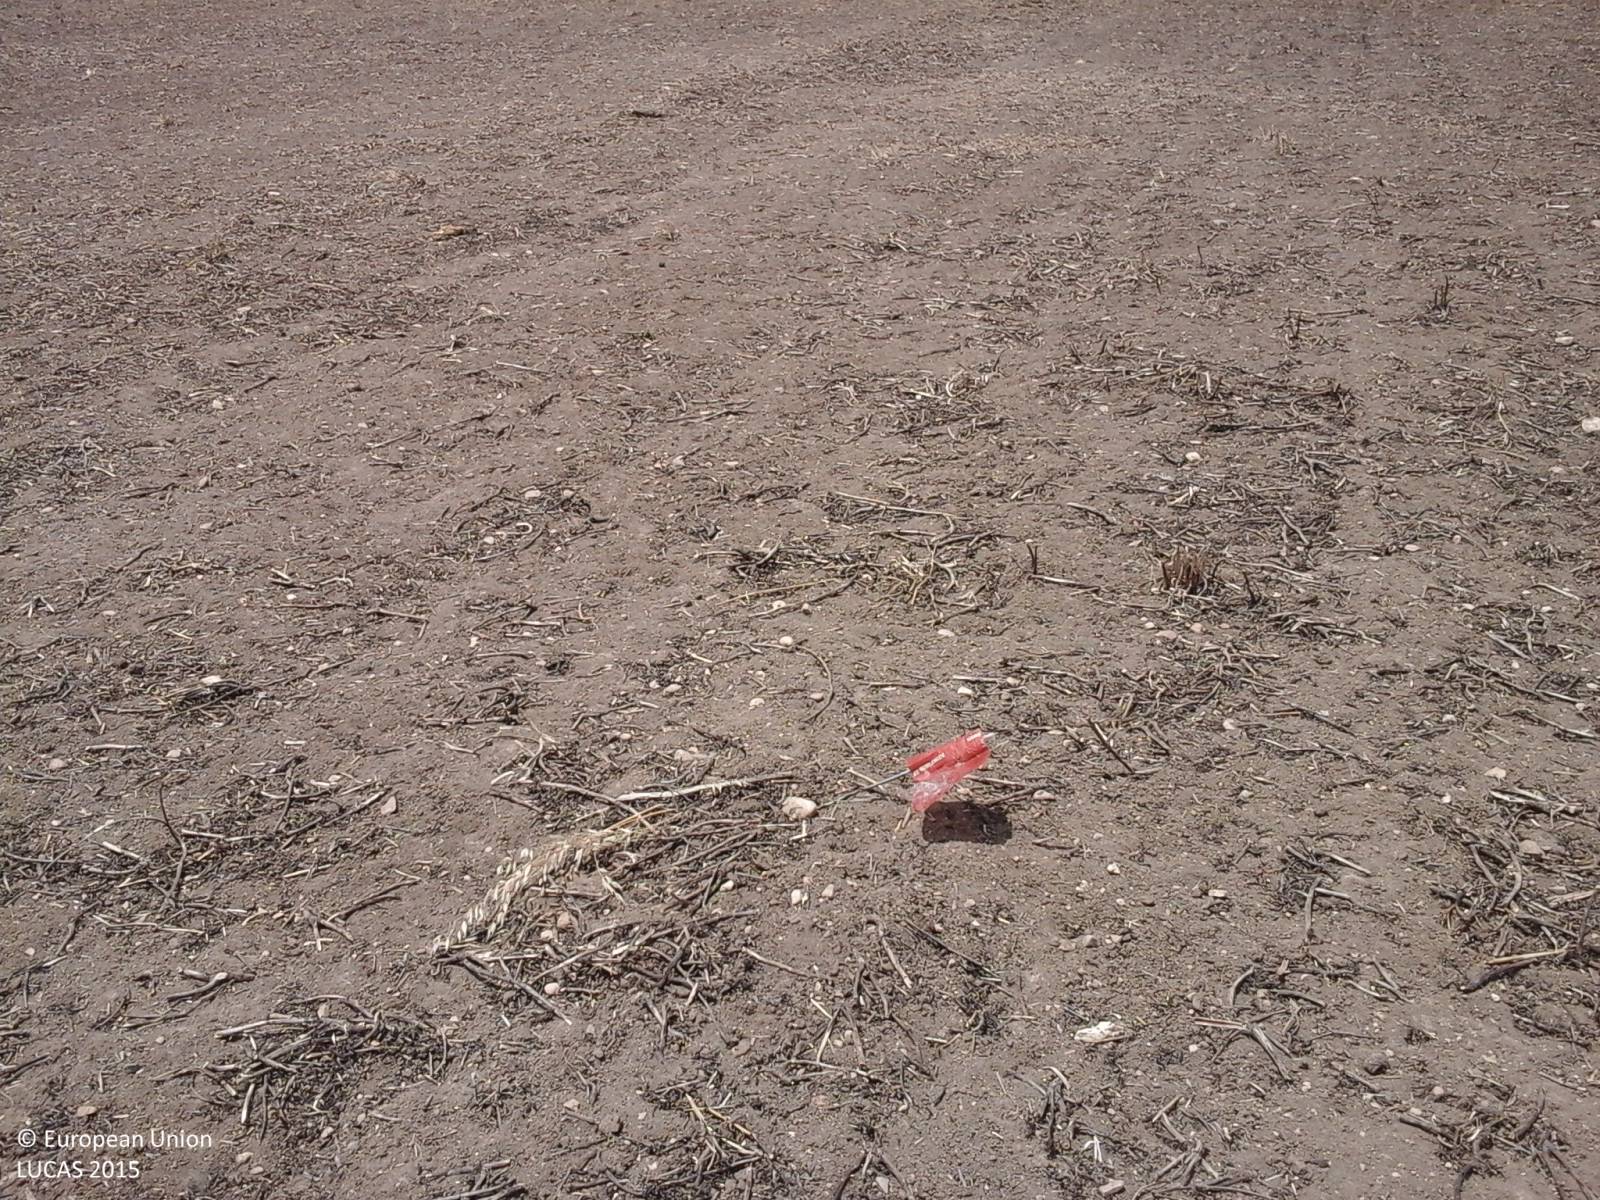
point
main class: Cropland
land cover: Oats
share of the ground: < 10 %
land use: Agriculture (excluding fallow land and kitchen gardens)
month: July
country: IT
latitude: 39.5900
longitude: 8.8076
